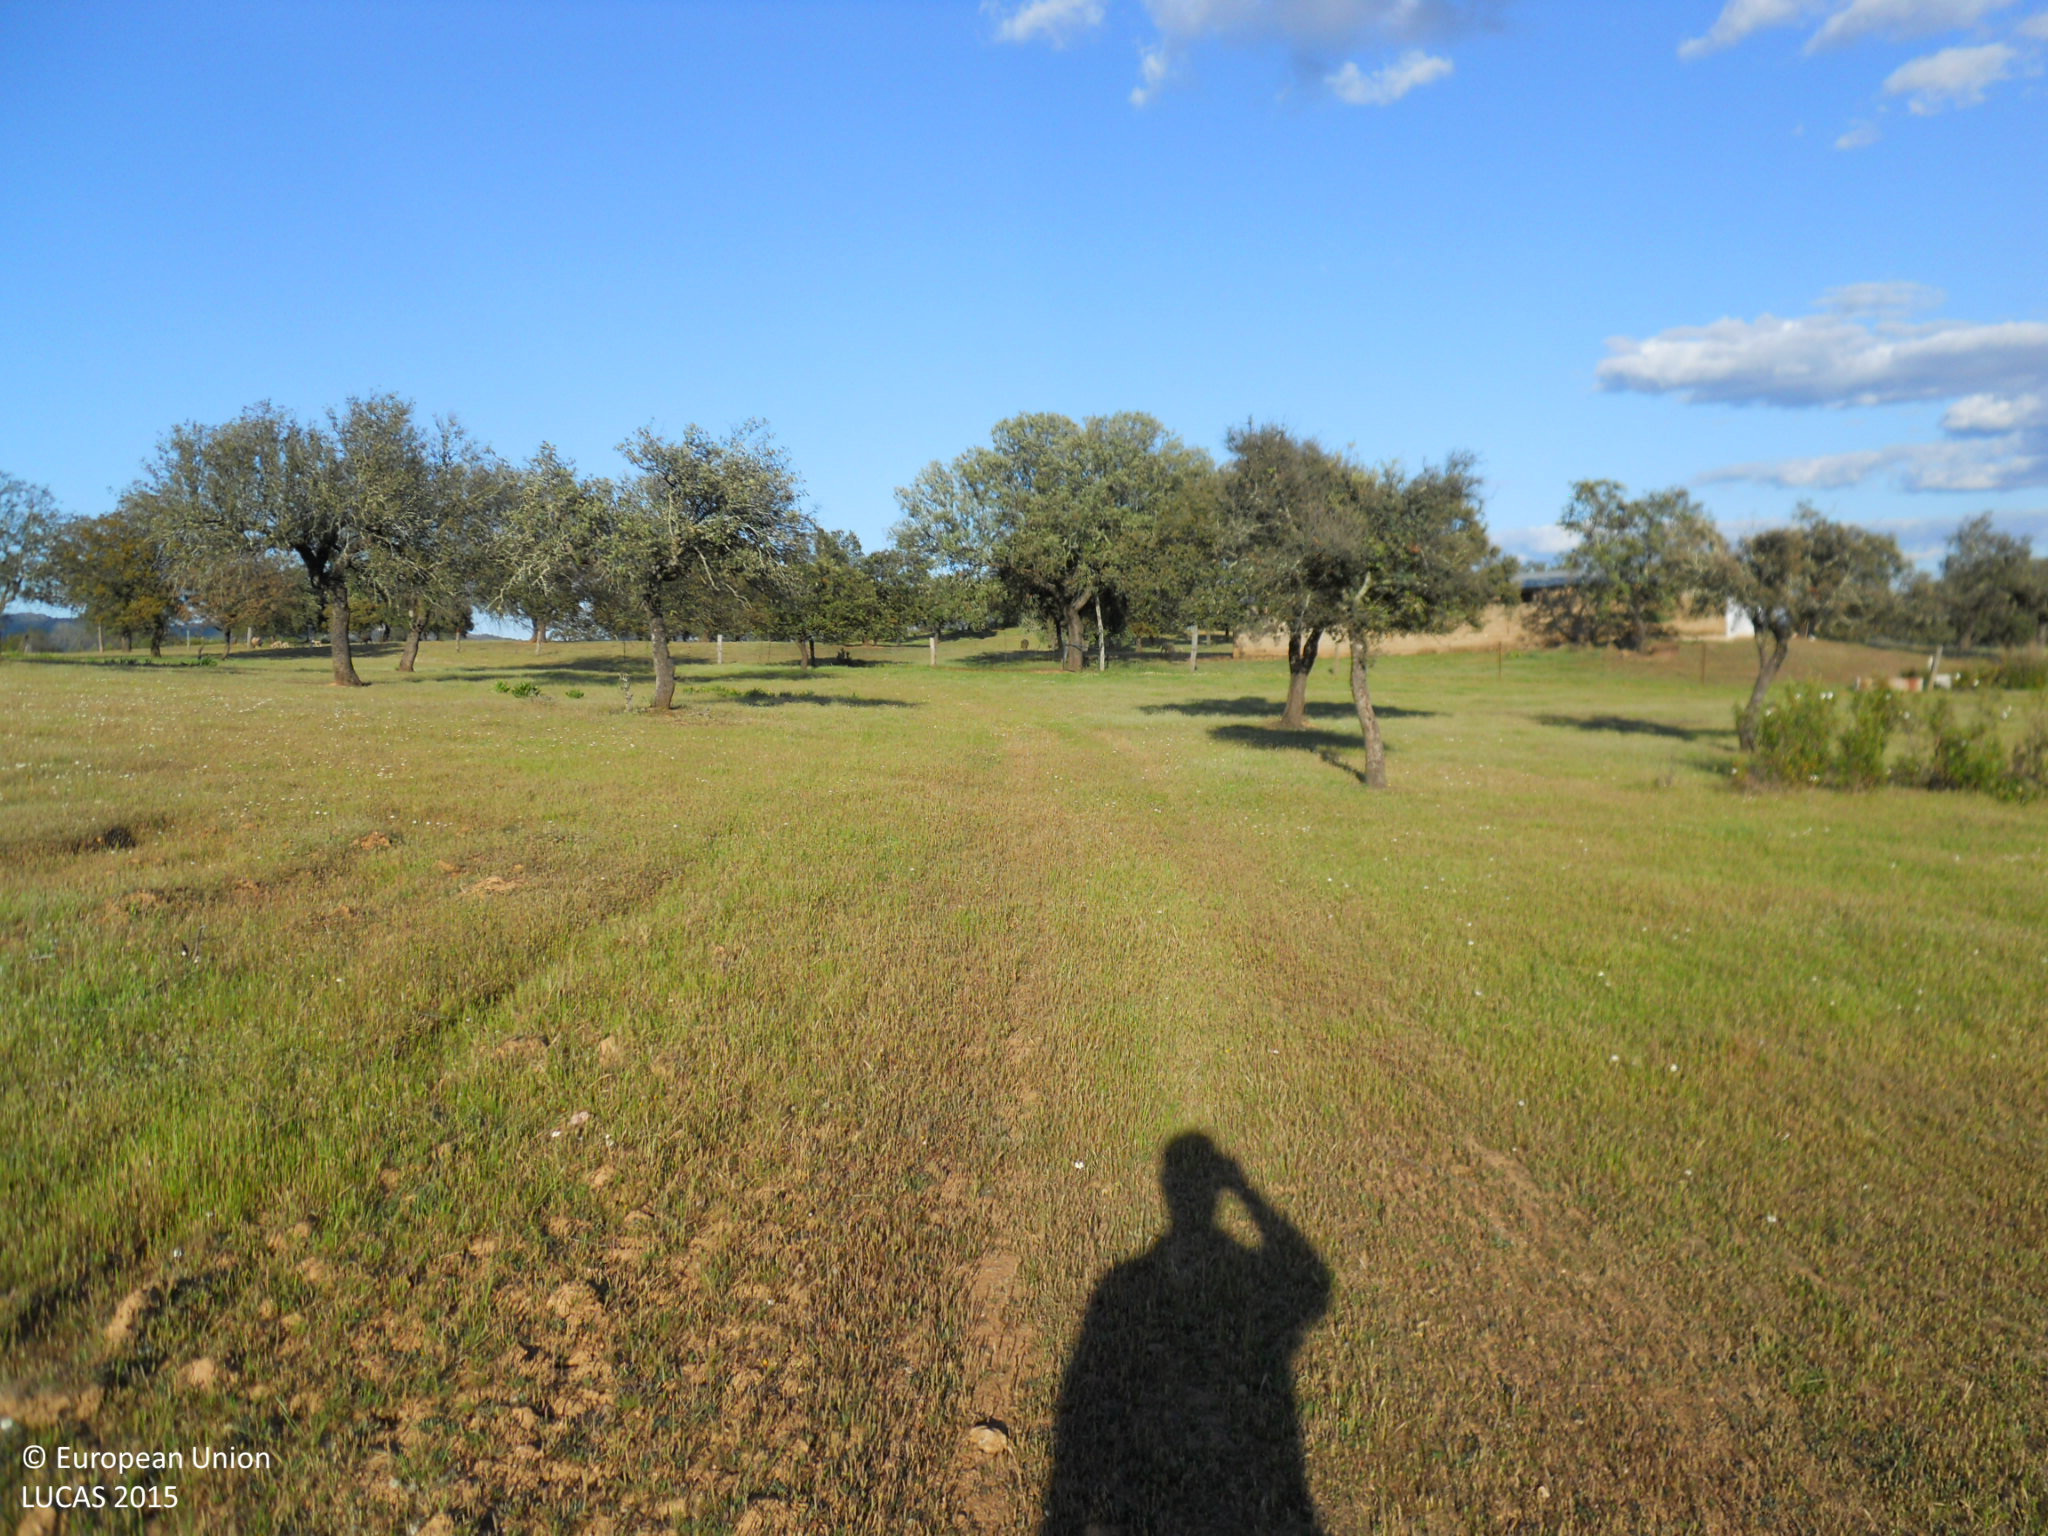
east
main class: Grassland
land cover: Grassland with sparse tree/shrub cover
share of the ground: > 75 %
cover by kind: herbaceous plants 90 %, broadleaved forest trees 5 %, shrubs 5 %
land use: Agriculture (excluding fallow land and kitchen gardens)
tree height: > 5 m
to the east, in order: Grassland with sparse tree/shrub cover; Fences; Broadleaved woodland
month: April
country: ES
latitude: 39.1984
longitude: -7.0879
